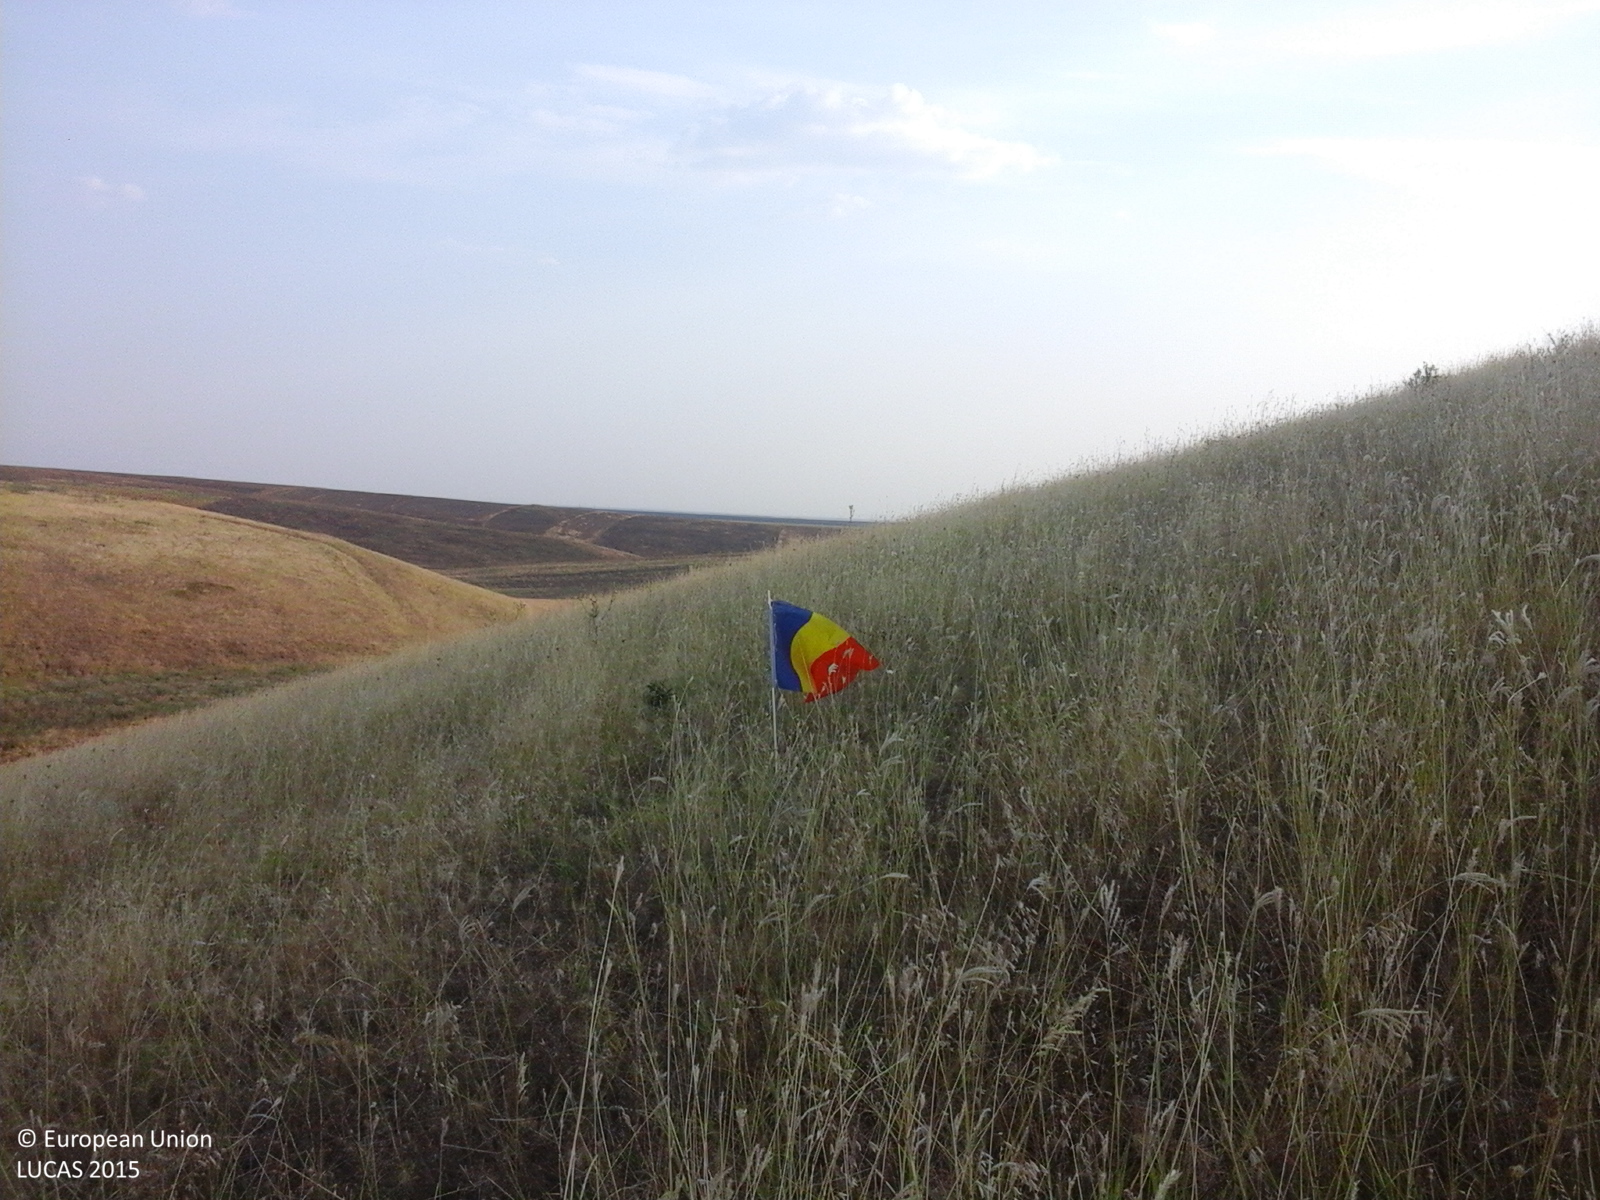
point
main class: Grassland
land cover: Grassland without tree/shrub cover
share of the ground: > 75 %
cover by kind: herbaceous plants 100 %
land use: Agriculture (excluding fallow land and kitchen gardens)
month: August
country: RO
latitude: 44.2662
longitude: 23.0855
